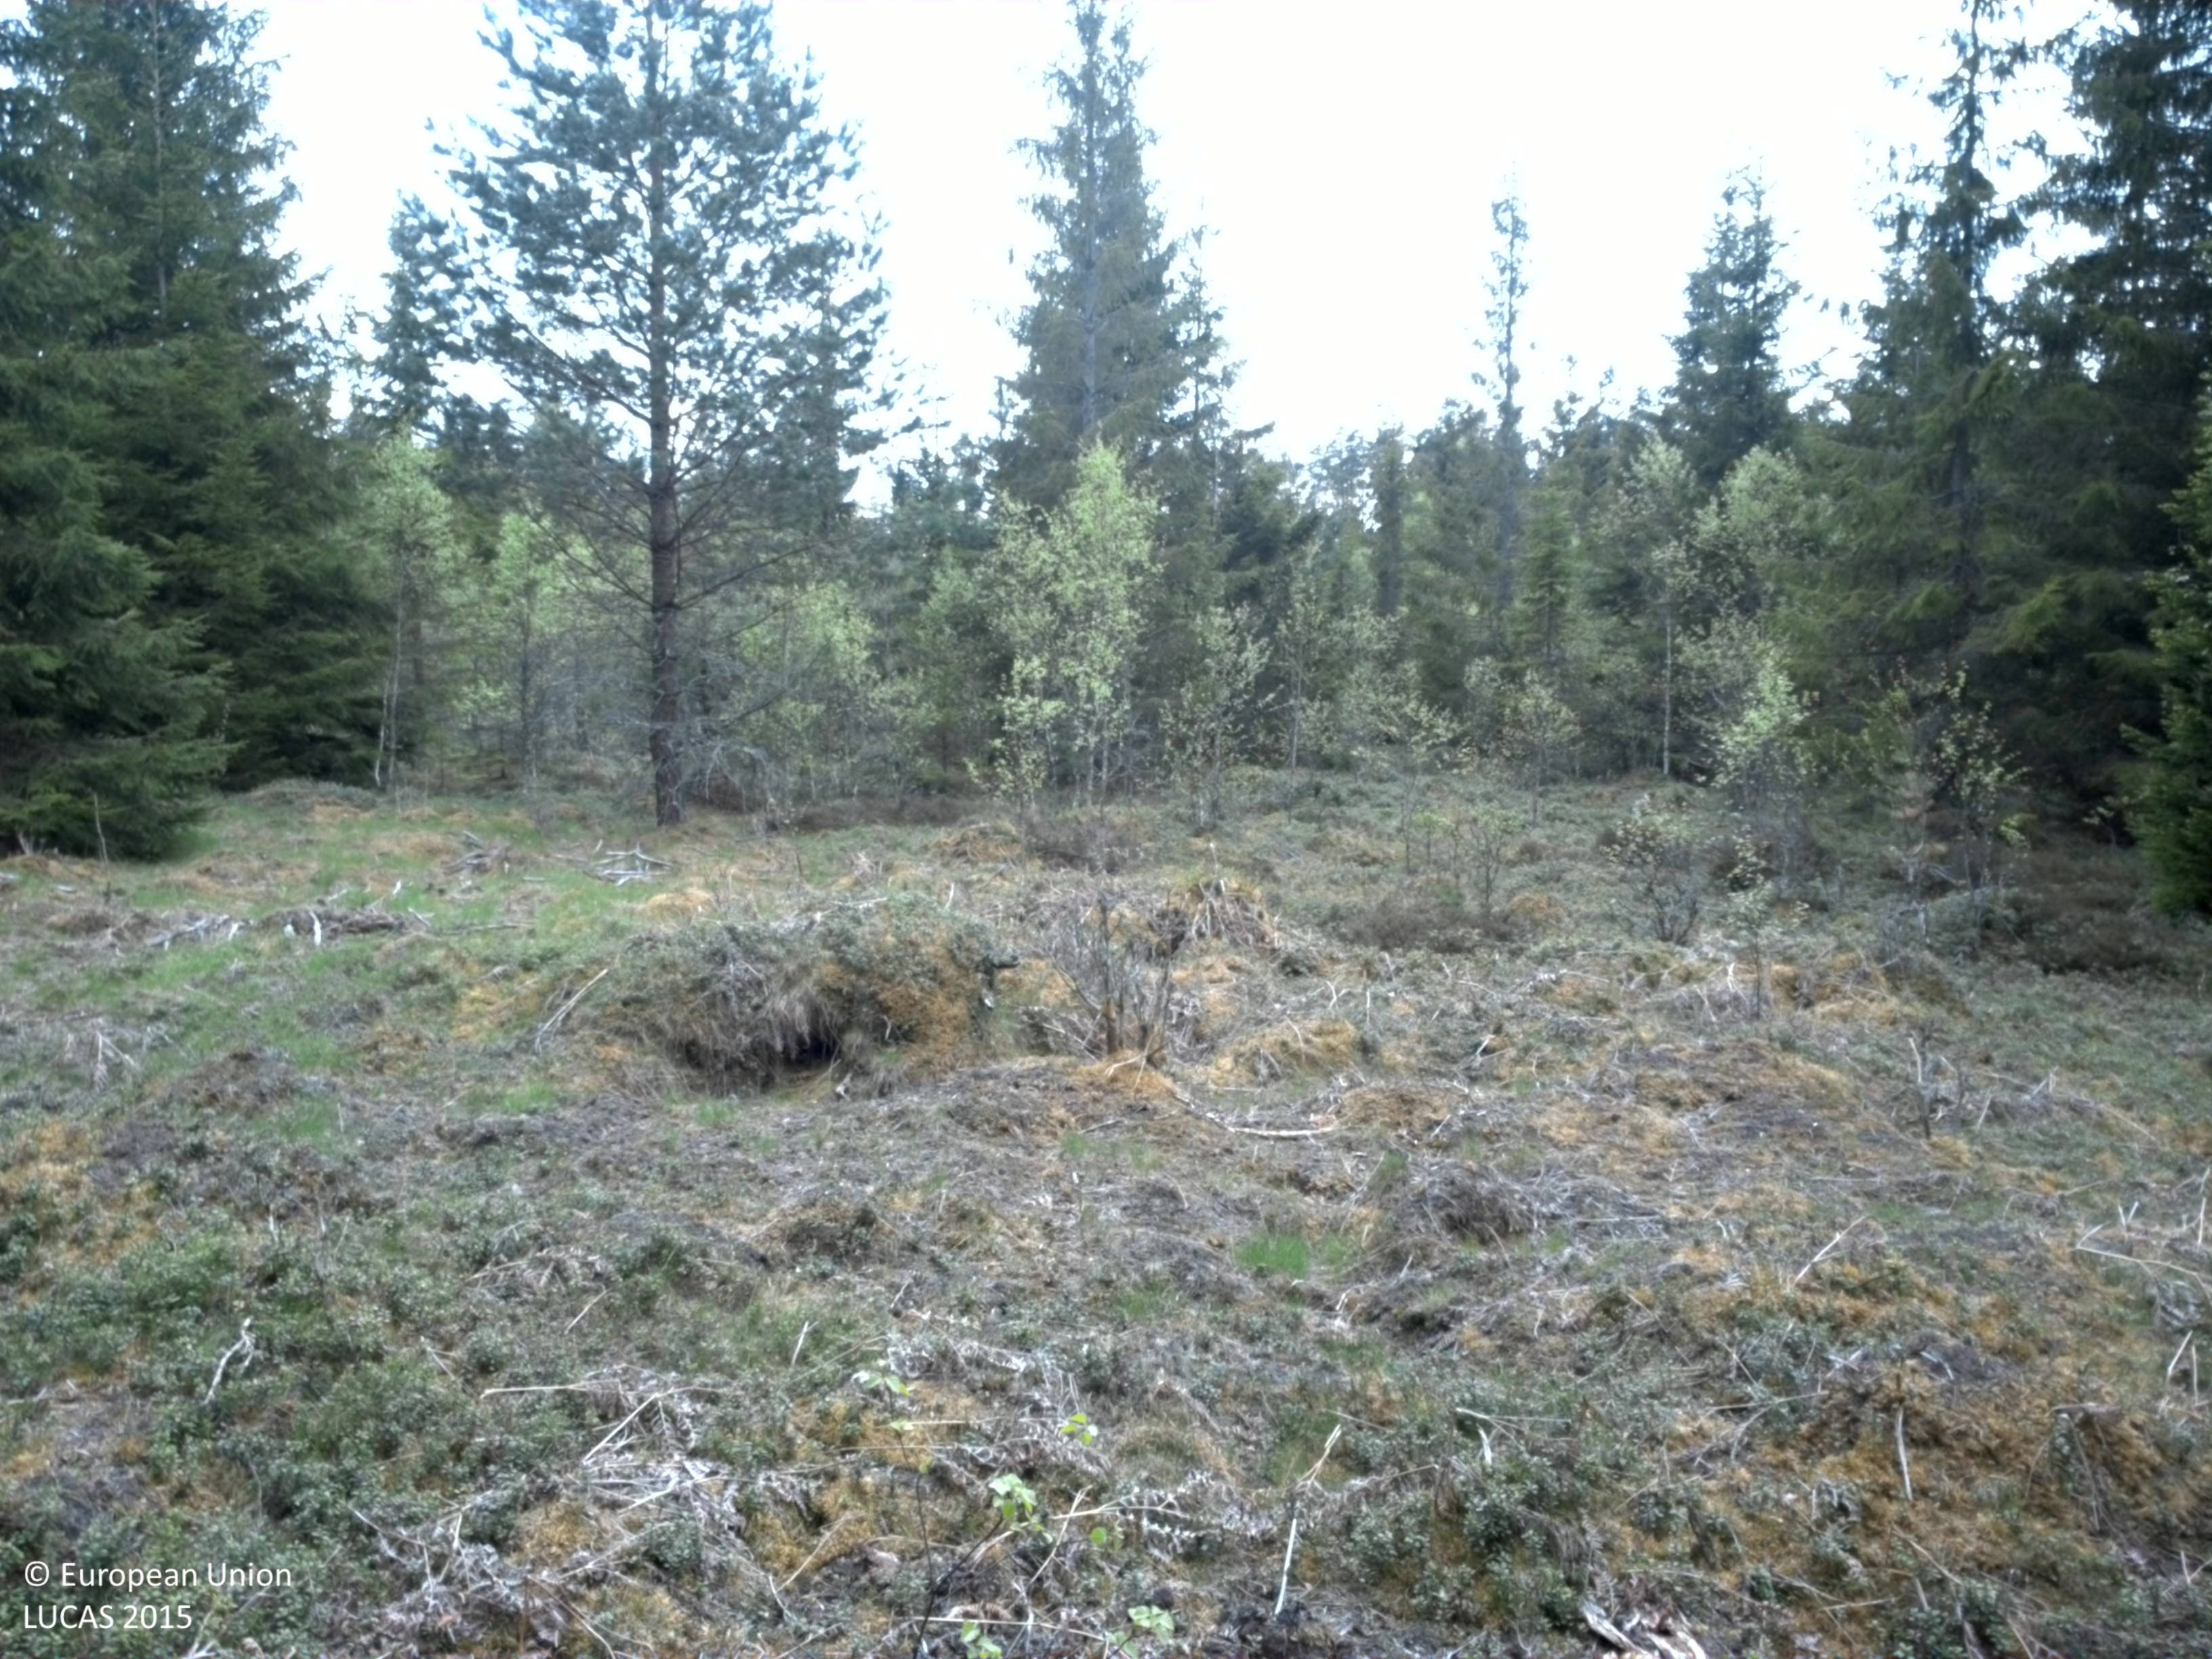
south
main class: Woodland
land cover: Spruce dominated coniferous woodland
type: boreal forest
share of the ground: 50 - 75 %
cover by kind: coniferous forest trees 50 %, shrubs 30 %, broadleaved forest trees 10 %, herbaceous plants 5 %, lichens and mosses 5 %
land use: Forestry
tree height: > 5 m
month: May
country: SE
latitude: 56.8933
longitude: 15.2014
